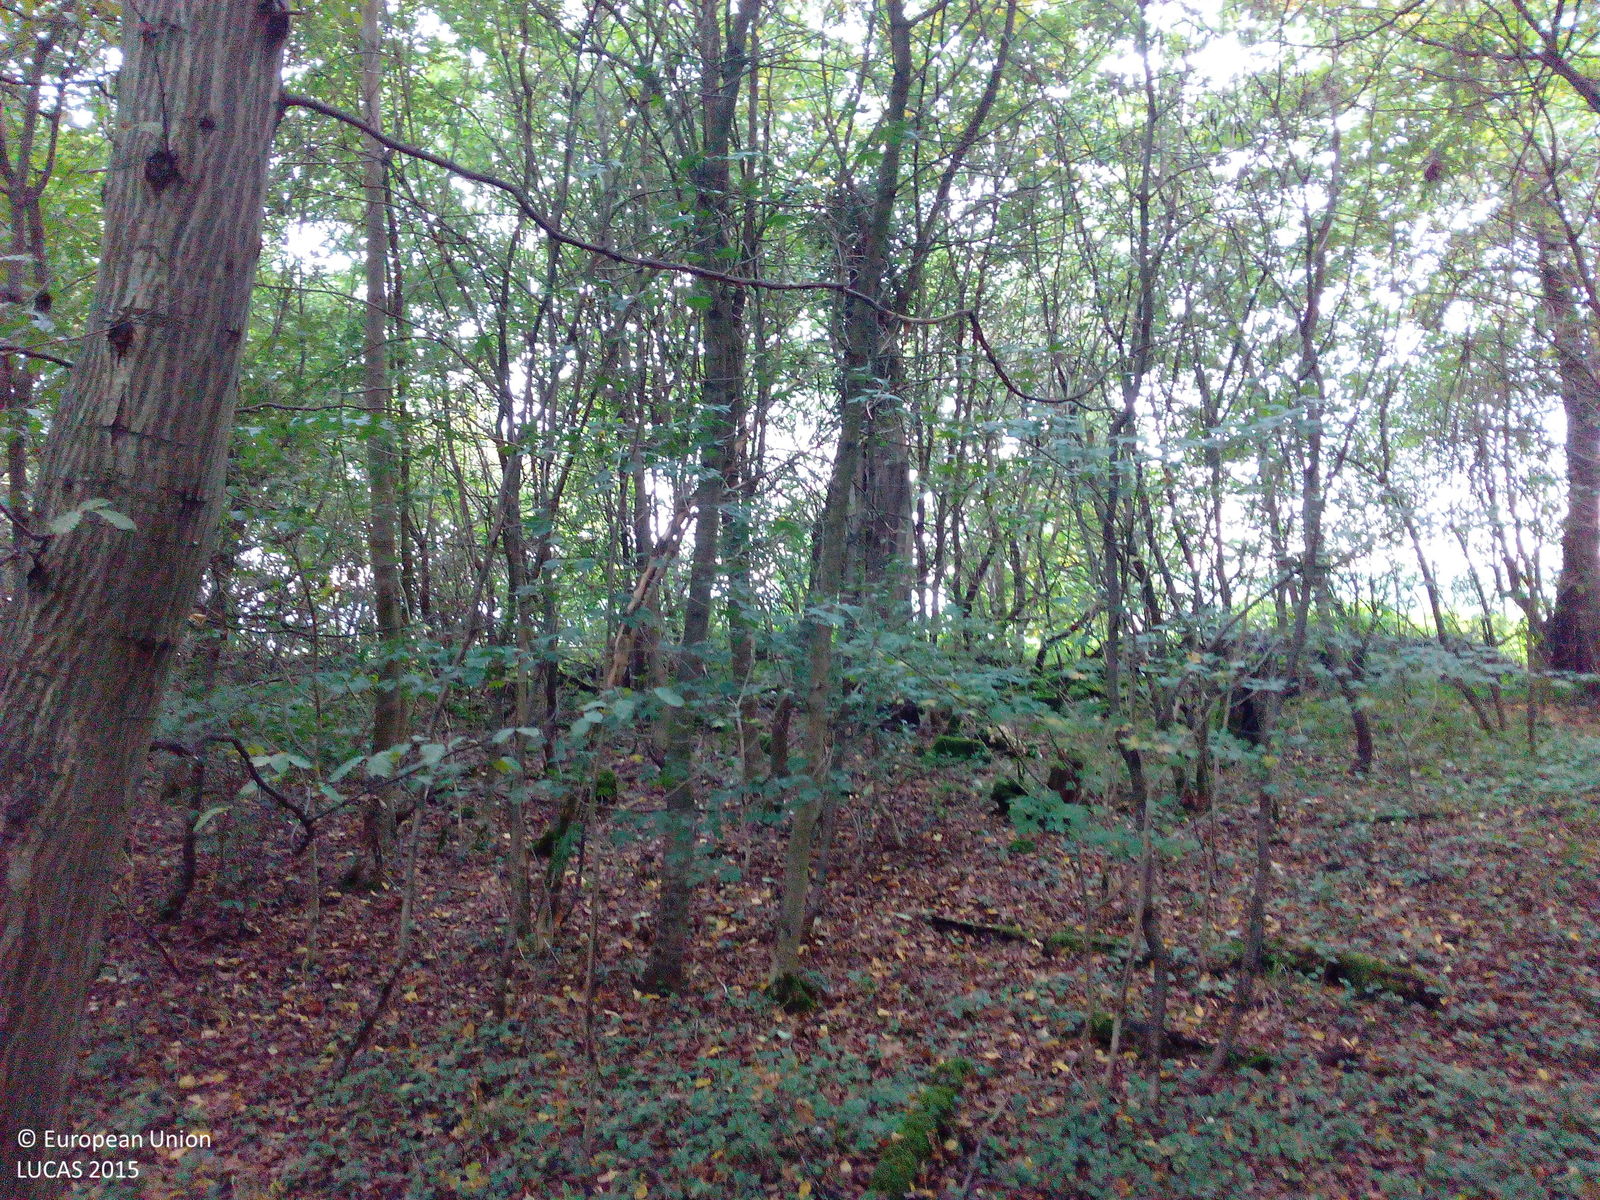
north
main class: Woodland
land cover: Broadleaved woodland
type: mesophytic deciduous forest
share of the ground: > 75 %
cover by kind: broadleaved forest trees 100 %
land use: Forestry
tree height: > 5 m
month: September
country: DE
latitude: 51.5505
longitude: 9.8414
